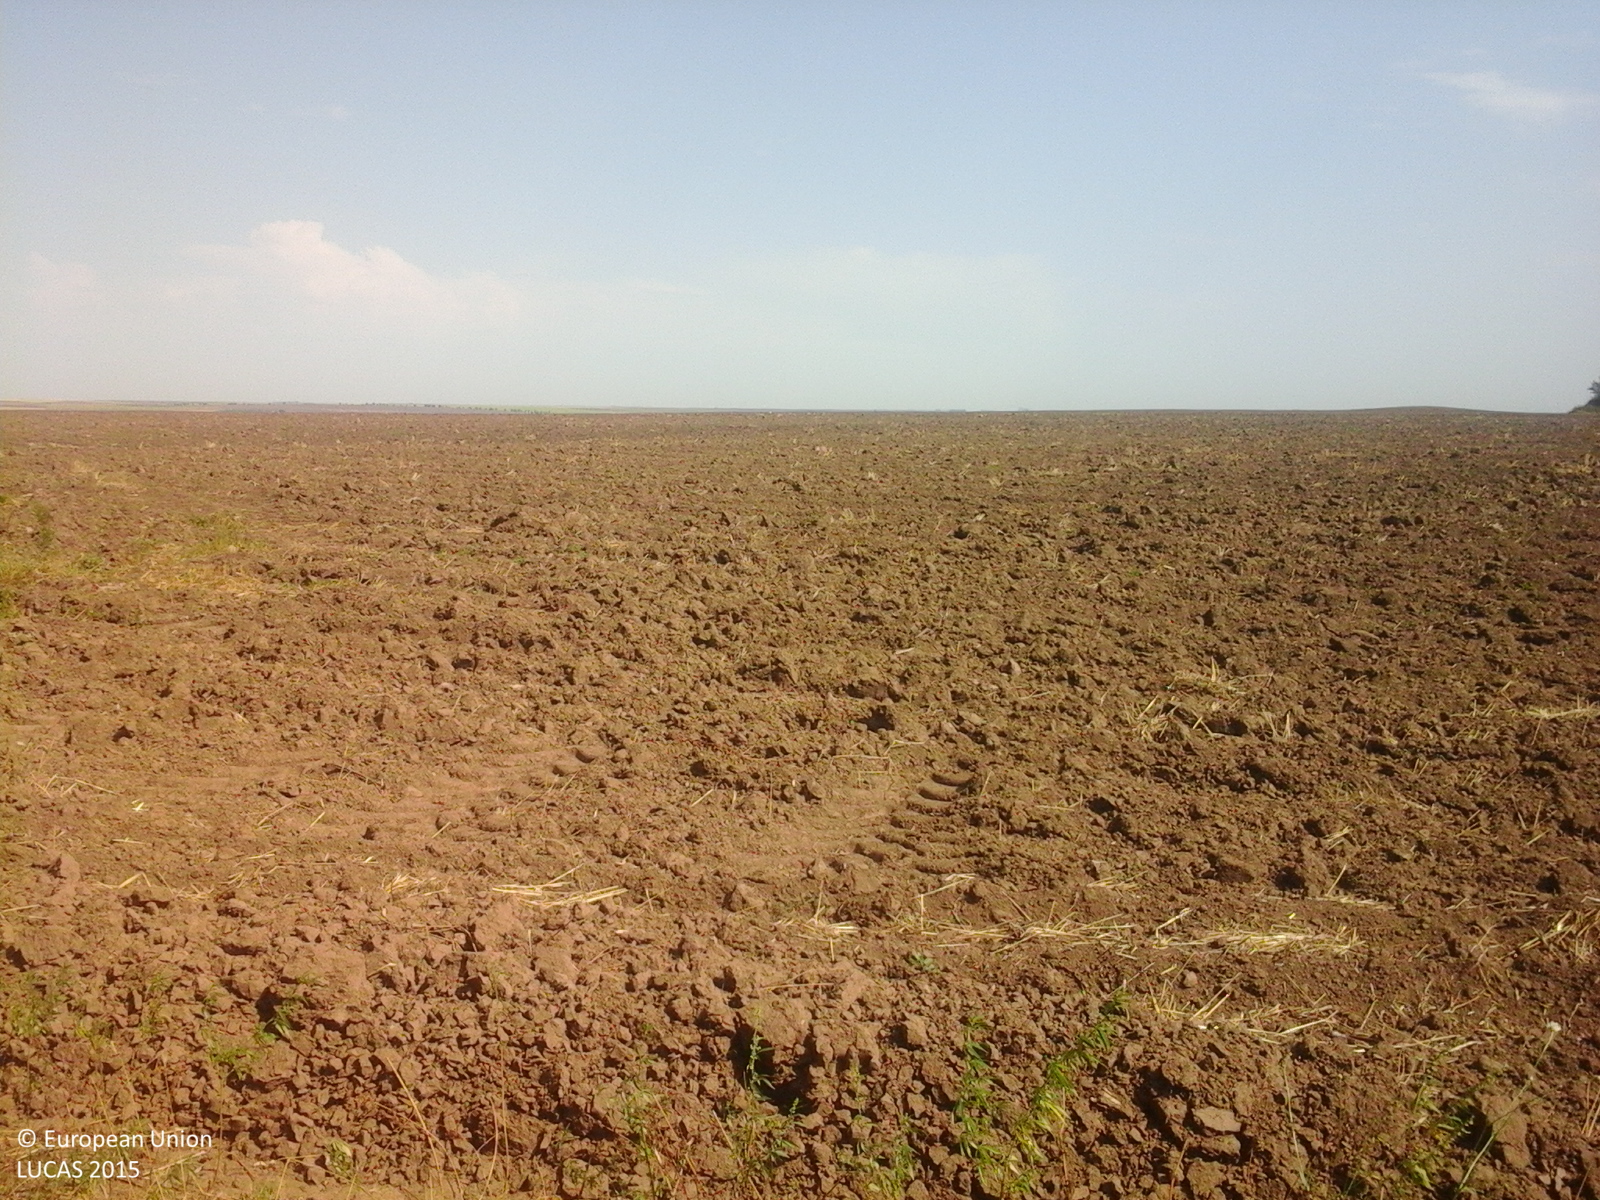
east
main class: Woodland
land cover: Broadleaved woodland
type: exotic forest
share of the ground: > 75 %
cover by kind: broadleaved forest trees 100 %
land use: Forestry
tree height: > 5 m
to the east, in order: Broadleaved woodland; Tracks; Common wheat
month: August
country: RO
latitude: 43.9881
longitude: 27.9424
